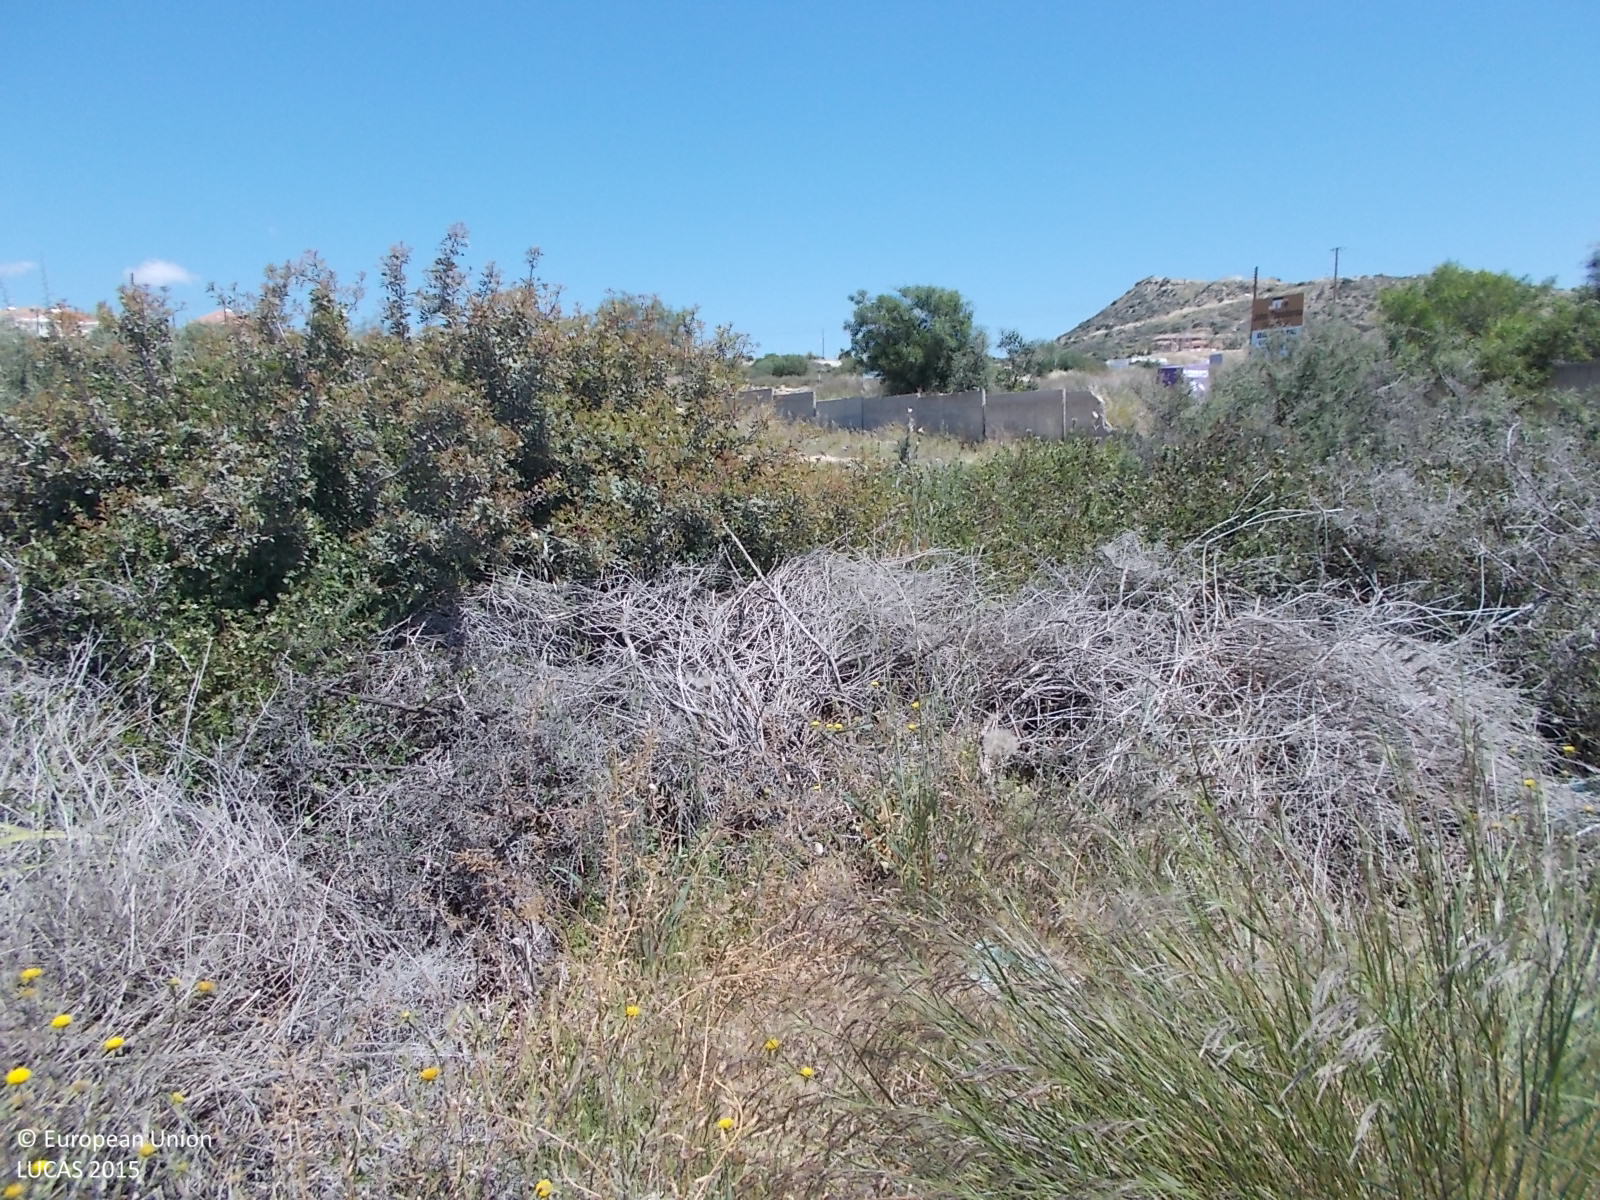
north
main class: Shrubland
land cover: Shrubland without tree cover
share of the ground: 50 - 75 %
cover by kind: shrubs 50 %, unconsolidated bare surface 30 %, herbaceous plants 20 %
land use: Semi-natural and natural areas not in use
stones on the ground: < 10 %
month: April
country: CY
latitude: 34.7208
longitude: 33.0658
